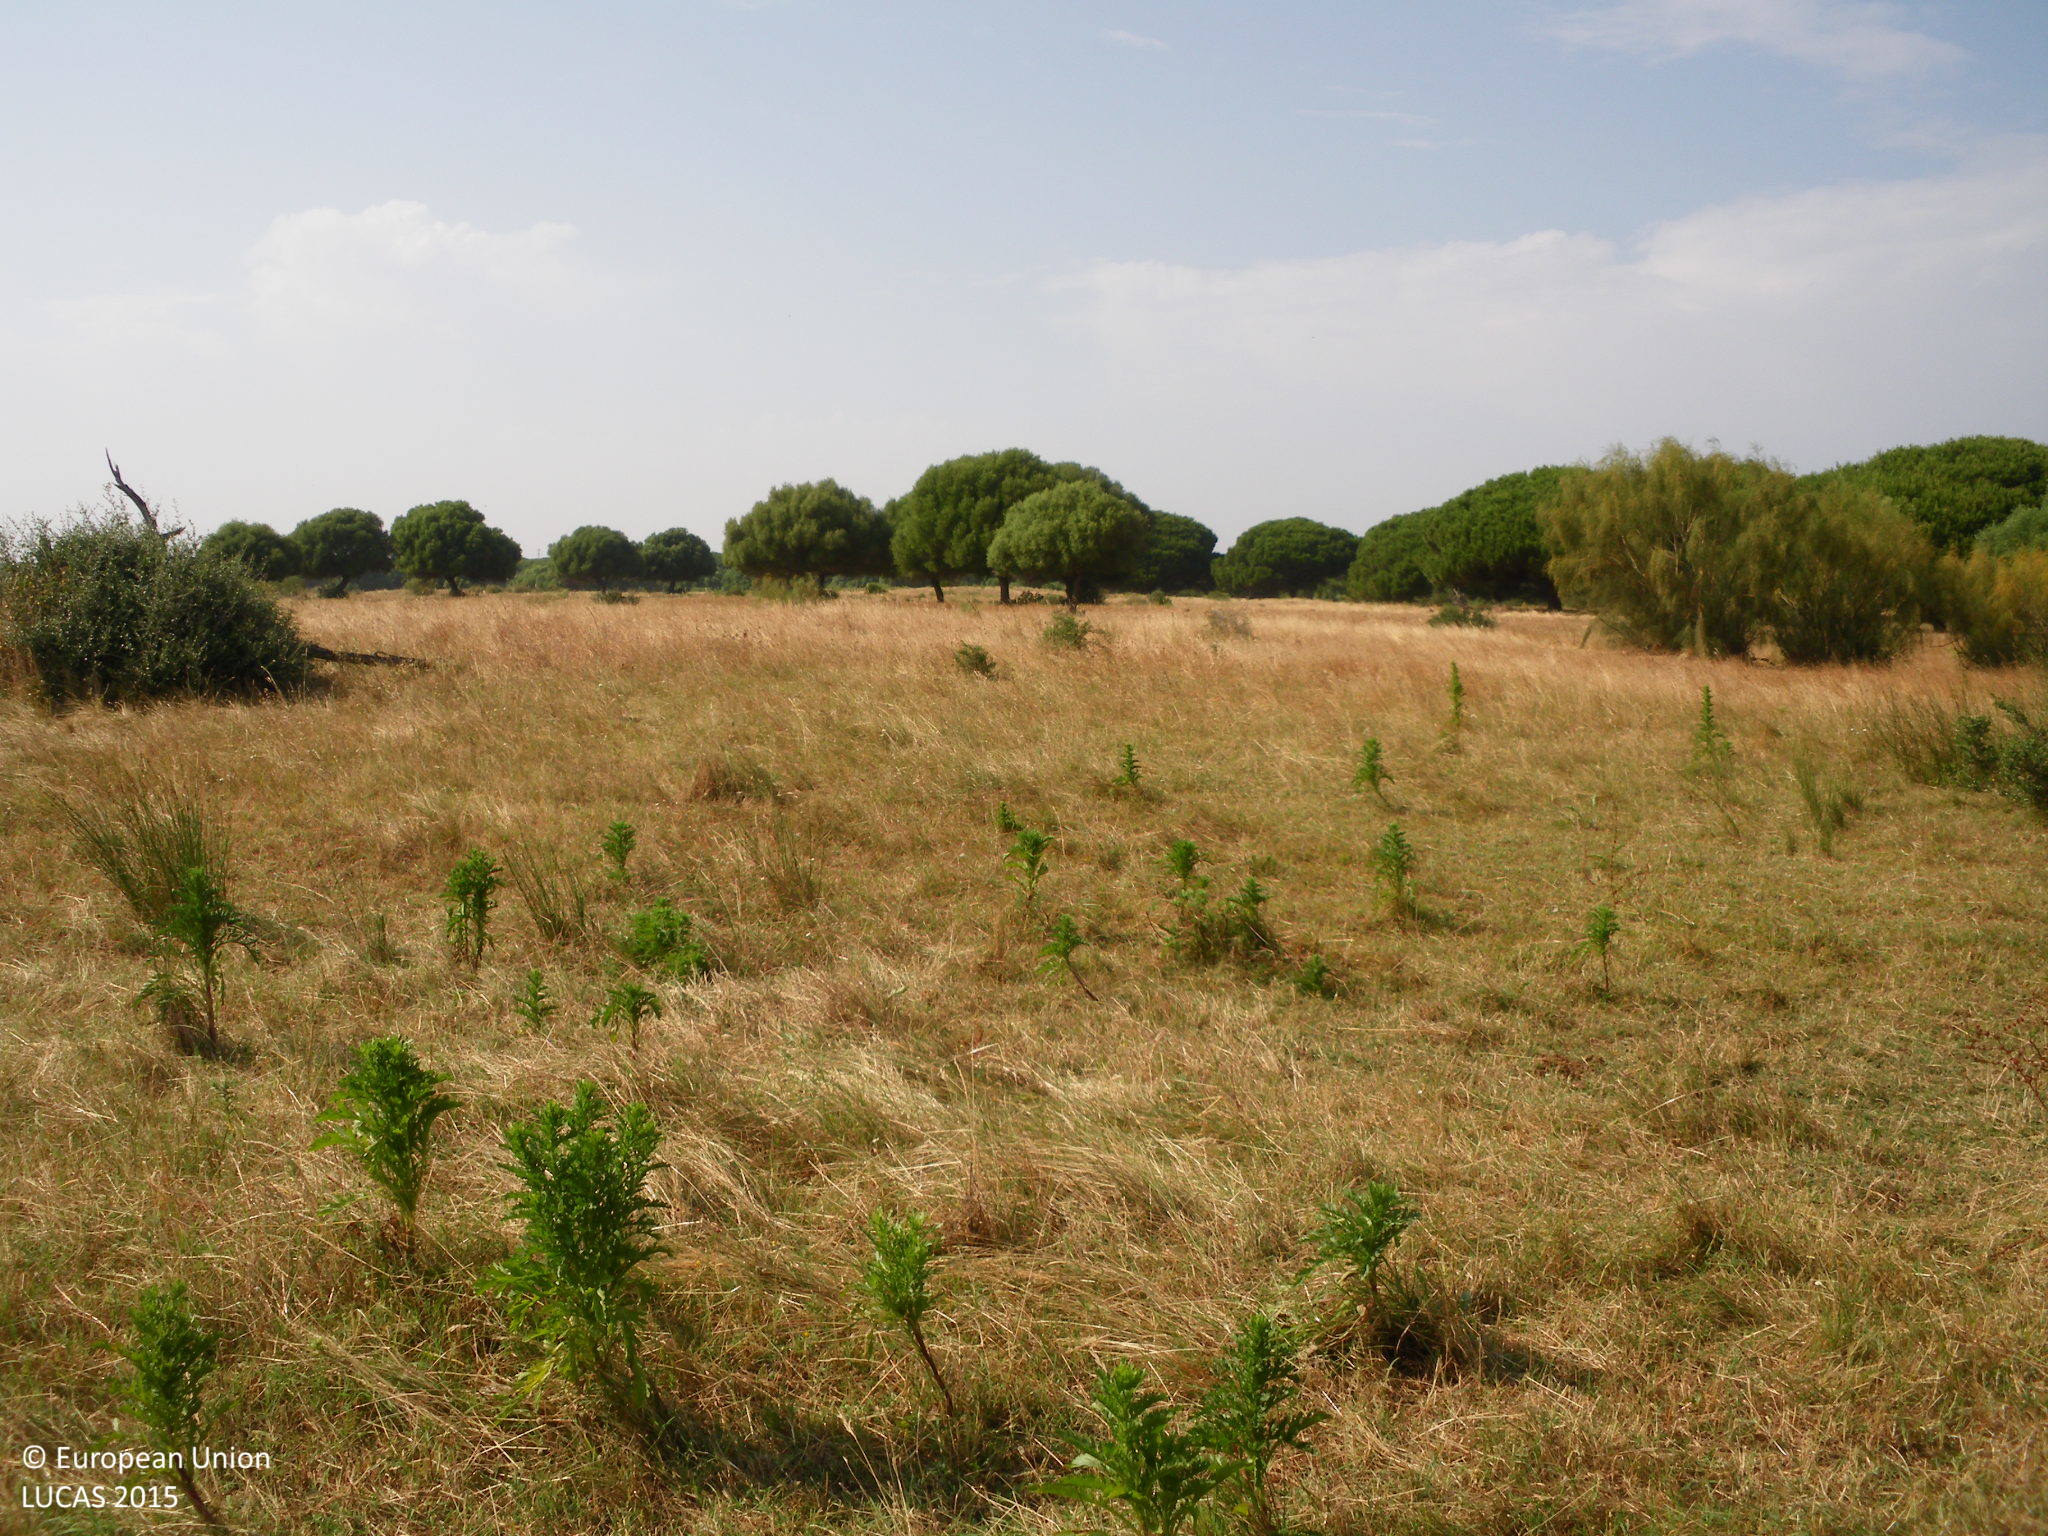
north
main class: Grassland
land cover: Grassland without tree/shrub cover
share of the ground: > 75 %
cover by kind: herbaceous plants 100 %
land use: Agriculture (excluding fallow land and kitchen gardens)
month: June
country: ES
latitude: 36.1943
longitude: -6.0256
